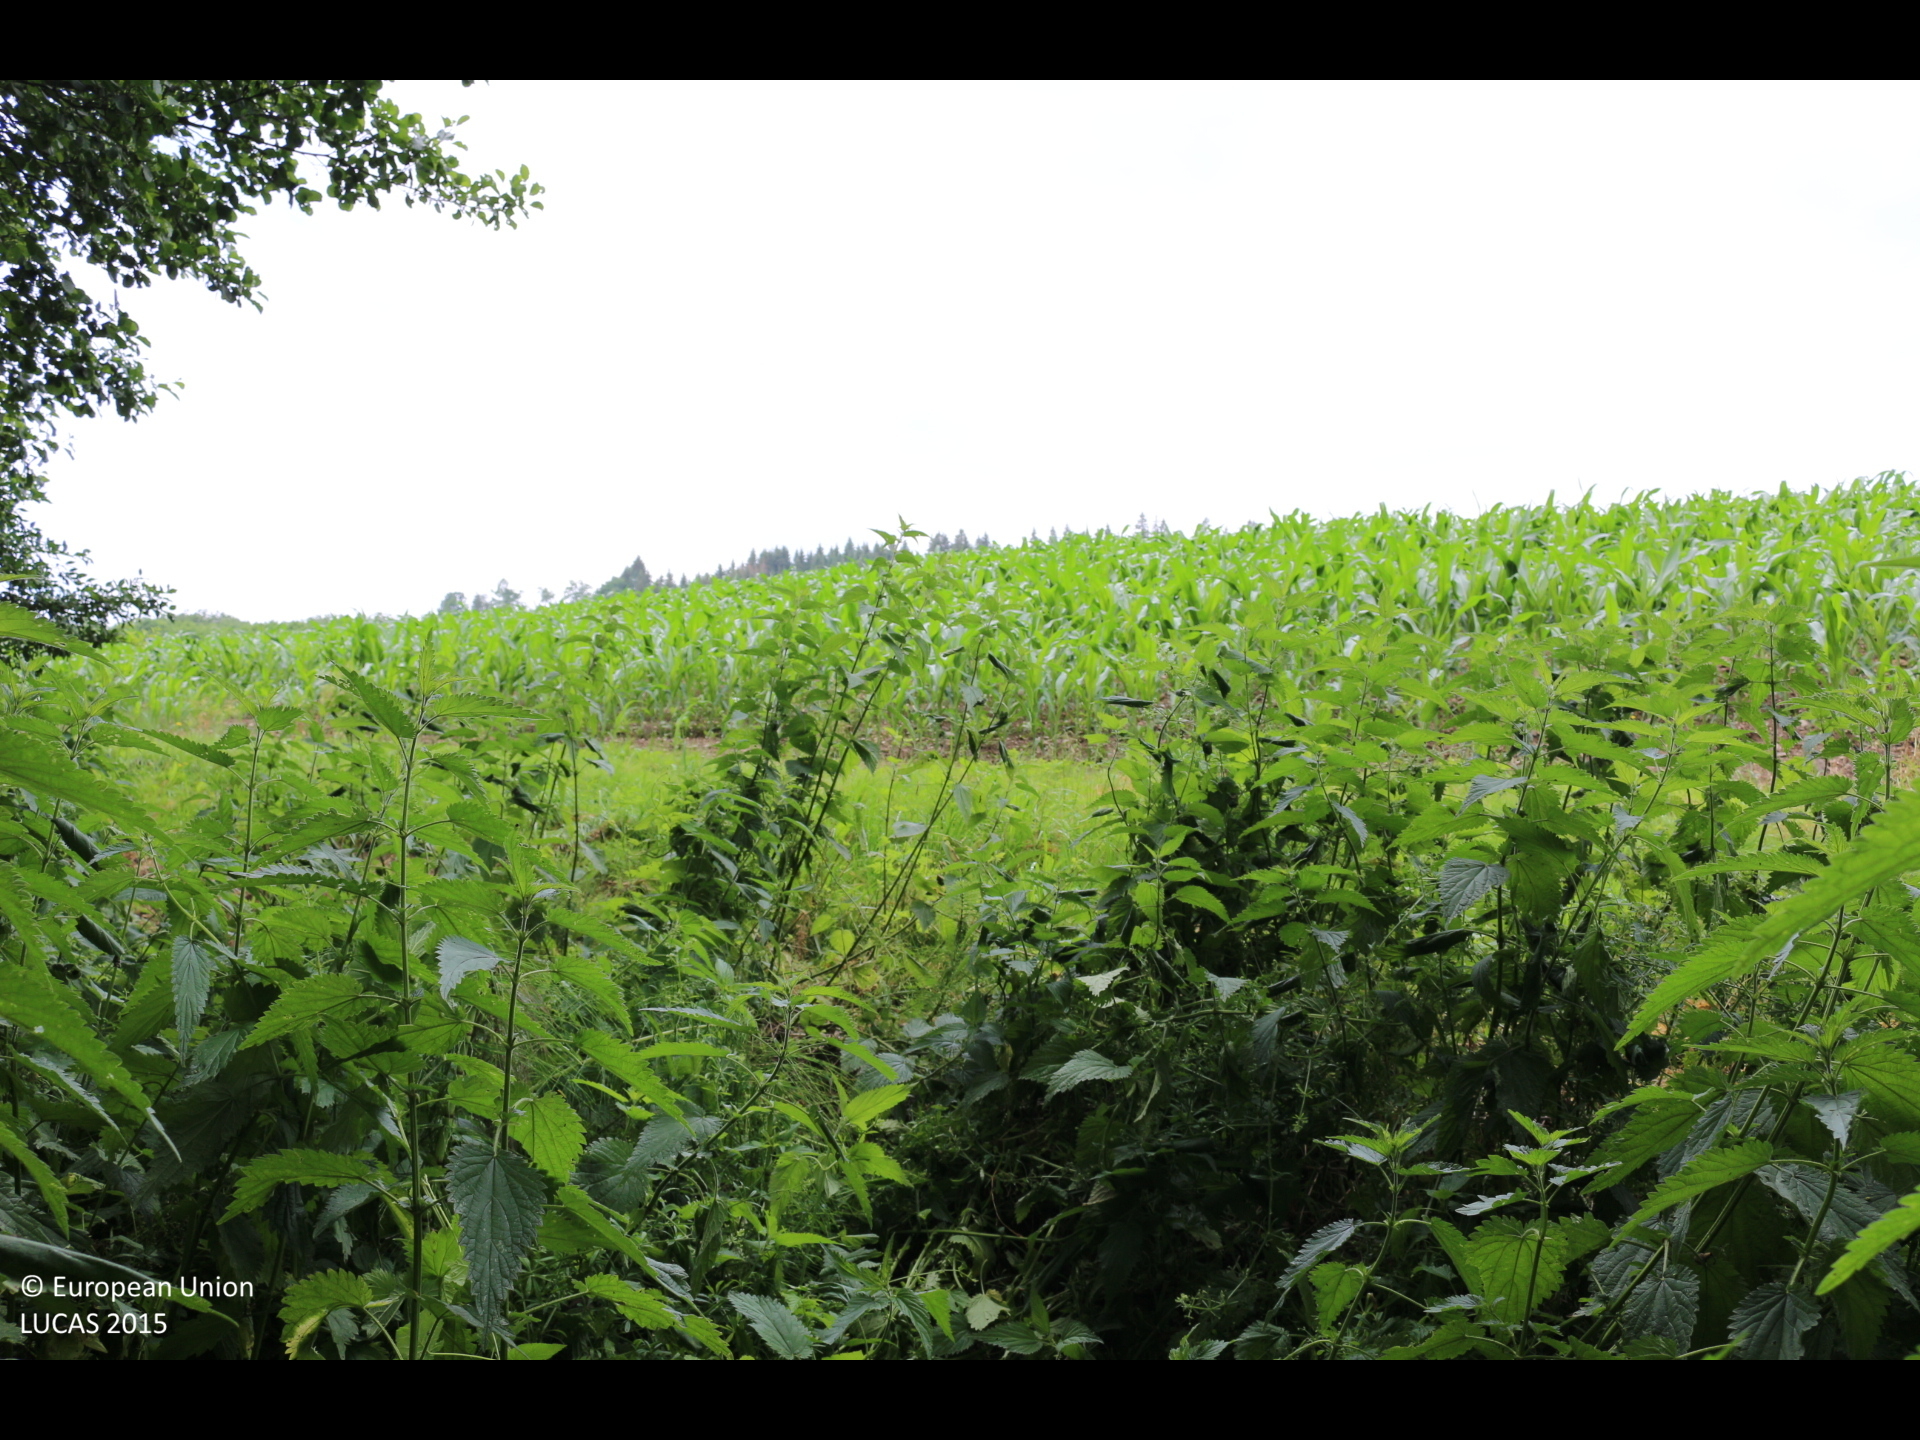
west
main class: Woodland
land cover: Broadleaved woodland
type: floodplain forest
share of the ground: > 75 %
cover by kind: broadleaved forest trees 100 %
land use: Forestry
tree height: > 5 m
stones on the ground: 10 - 25 %
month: June
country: AT
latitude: 46.7145
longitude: 14.3277
